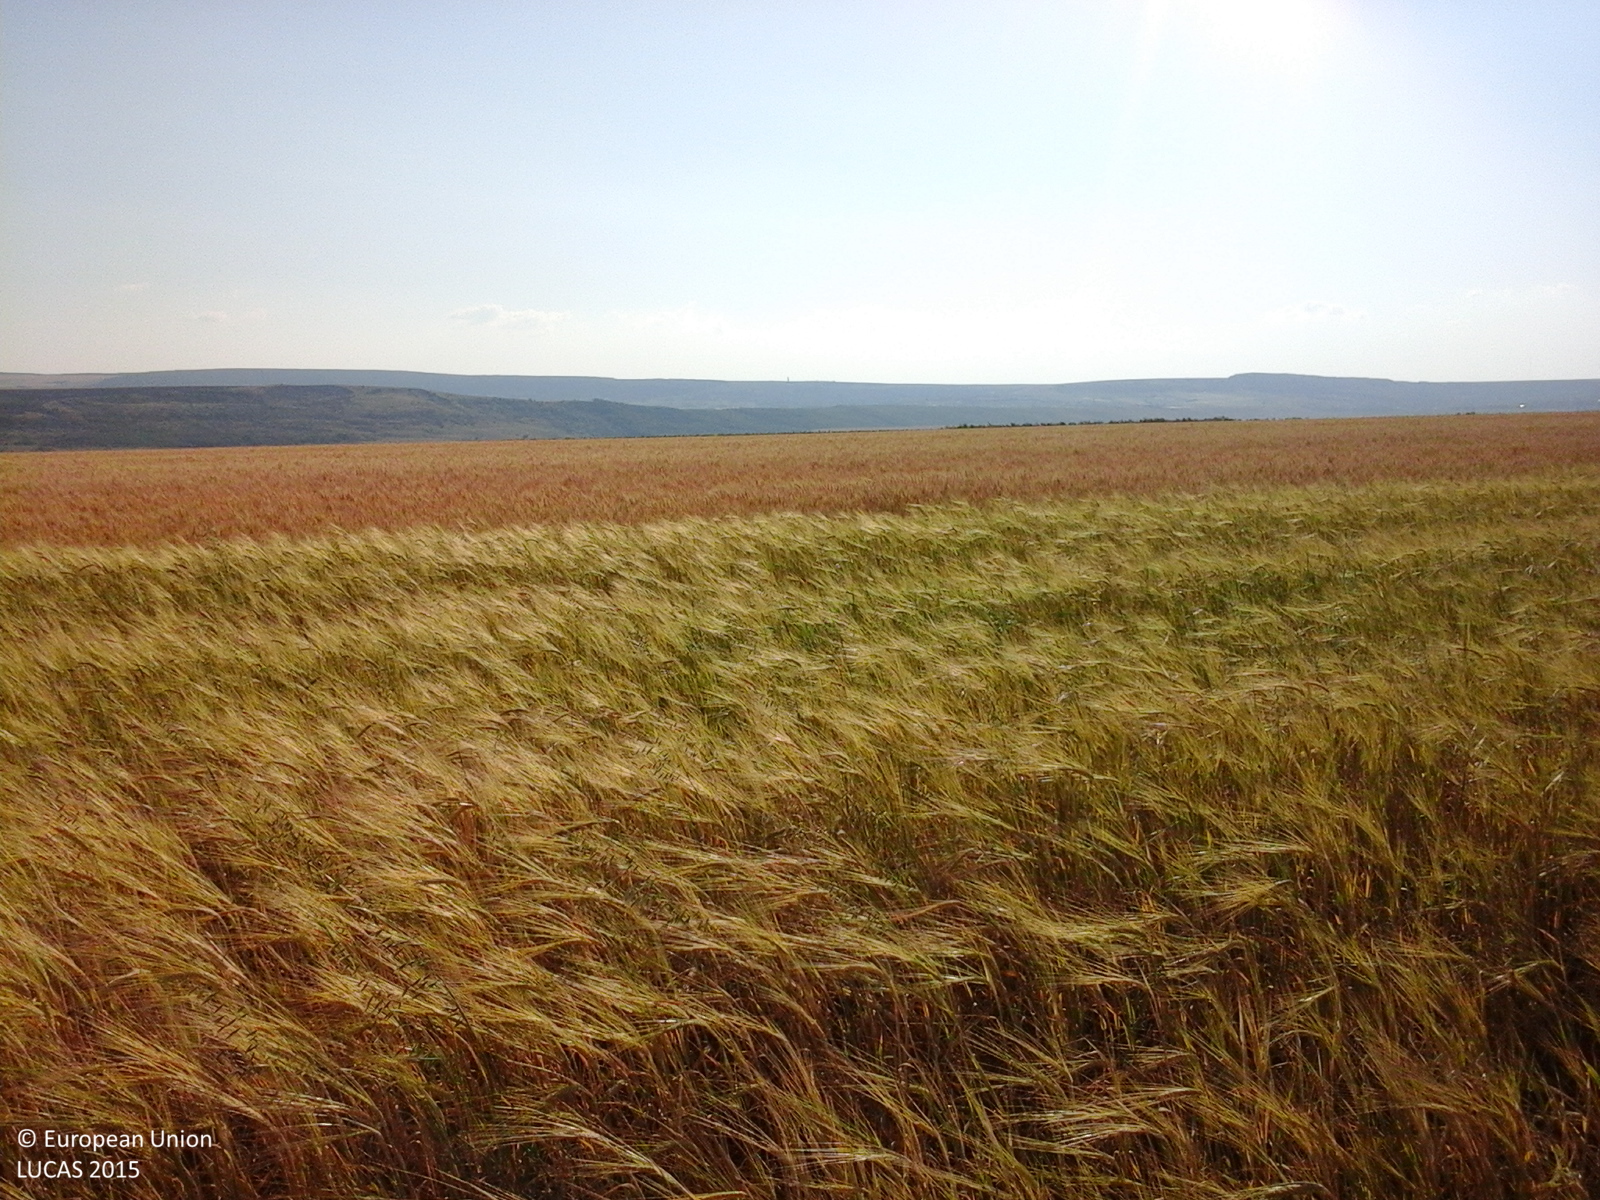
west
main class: Cropland
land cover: Barley
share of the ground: > 75 %
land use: Agriculture (excluding fallow land and kitchen gardens)
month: June
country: RO
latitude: 46.8011
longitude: 28.0958
